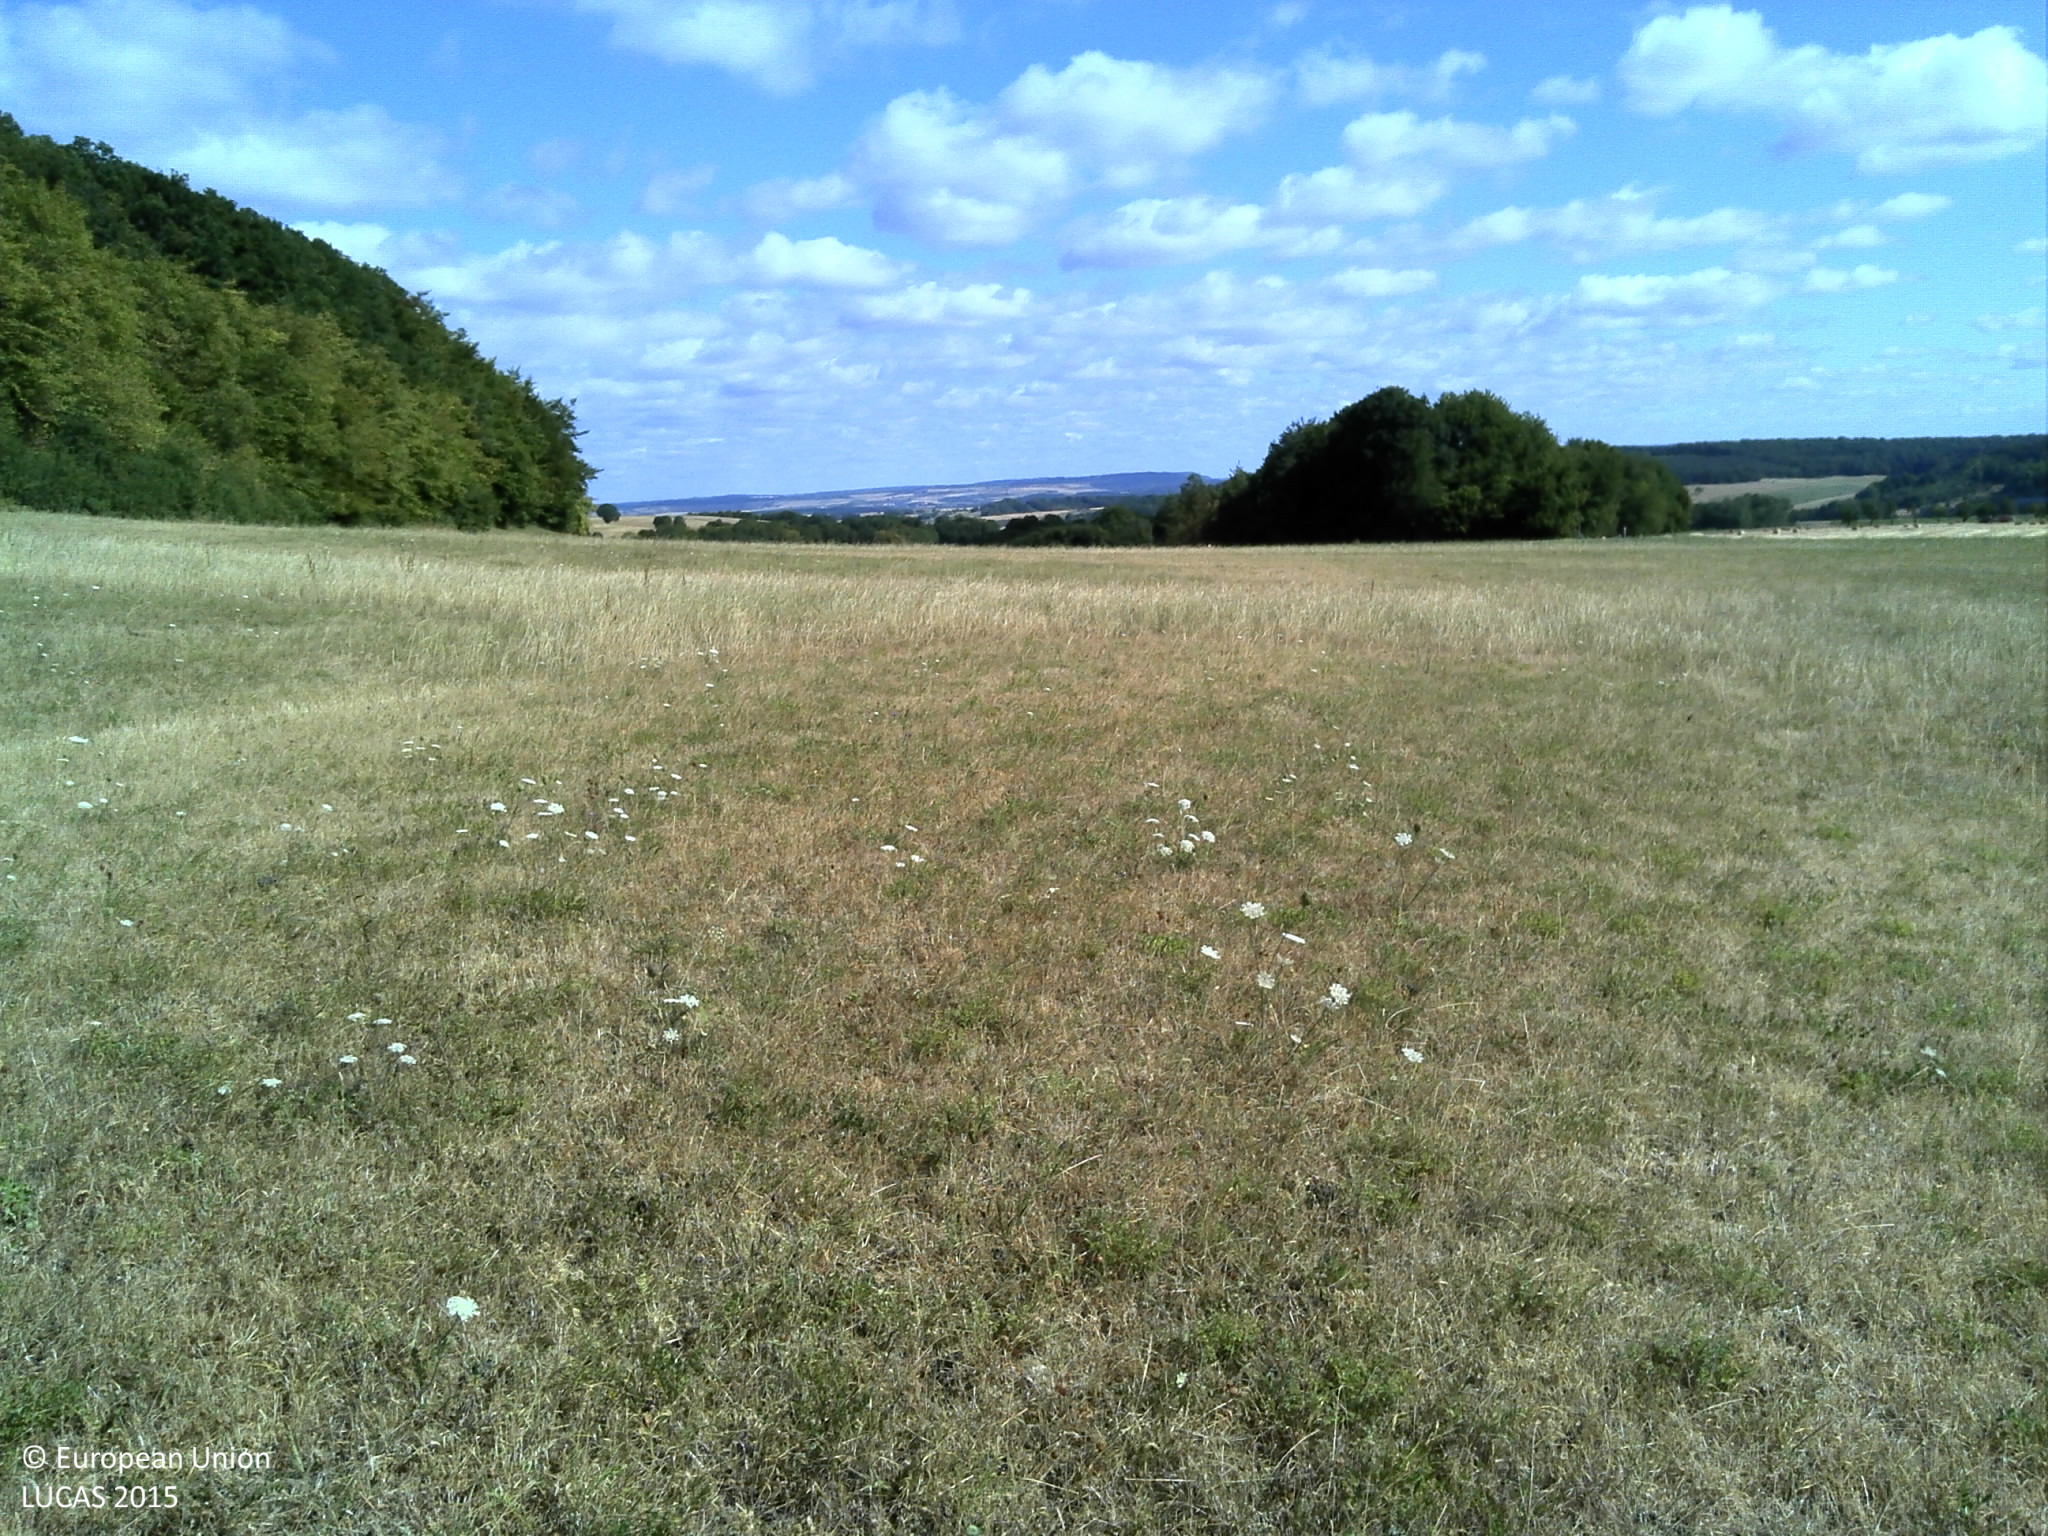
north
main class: Grassland
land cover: Grassland without tree/shrub cover
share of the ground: > 75 %
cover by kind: herbaceous plants 100 %
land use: Agriculture (excluding fallow land and kitchen gardens)
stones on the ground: 10 - 25 %
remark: Harvested field
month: July
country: FR
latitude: 48.2401
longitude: 5.9742
